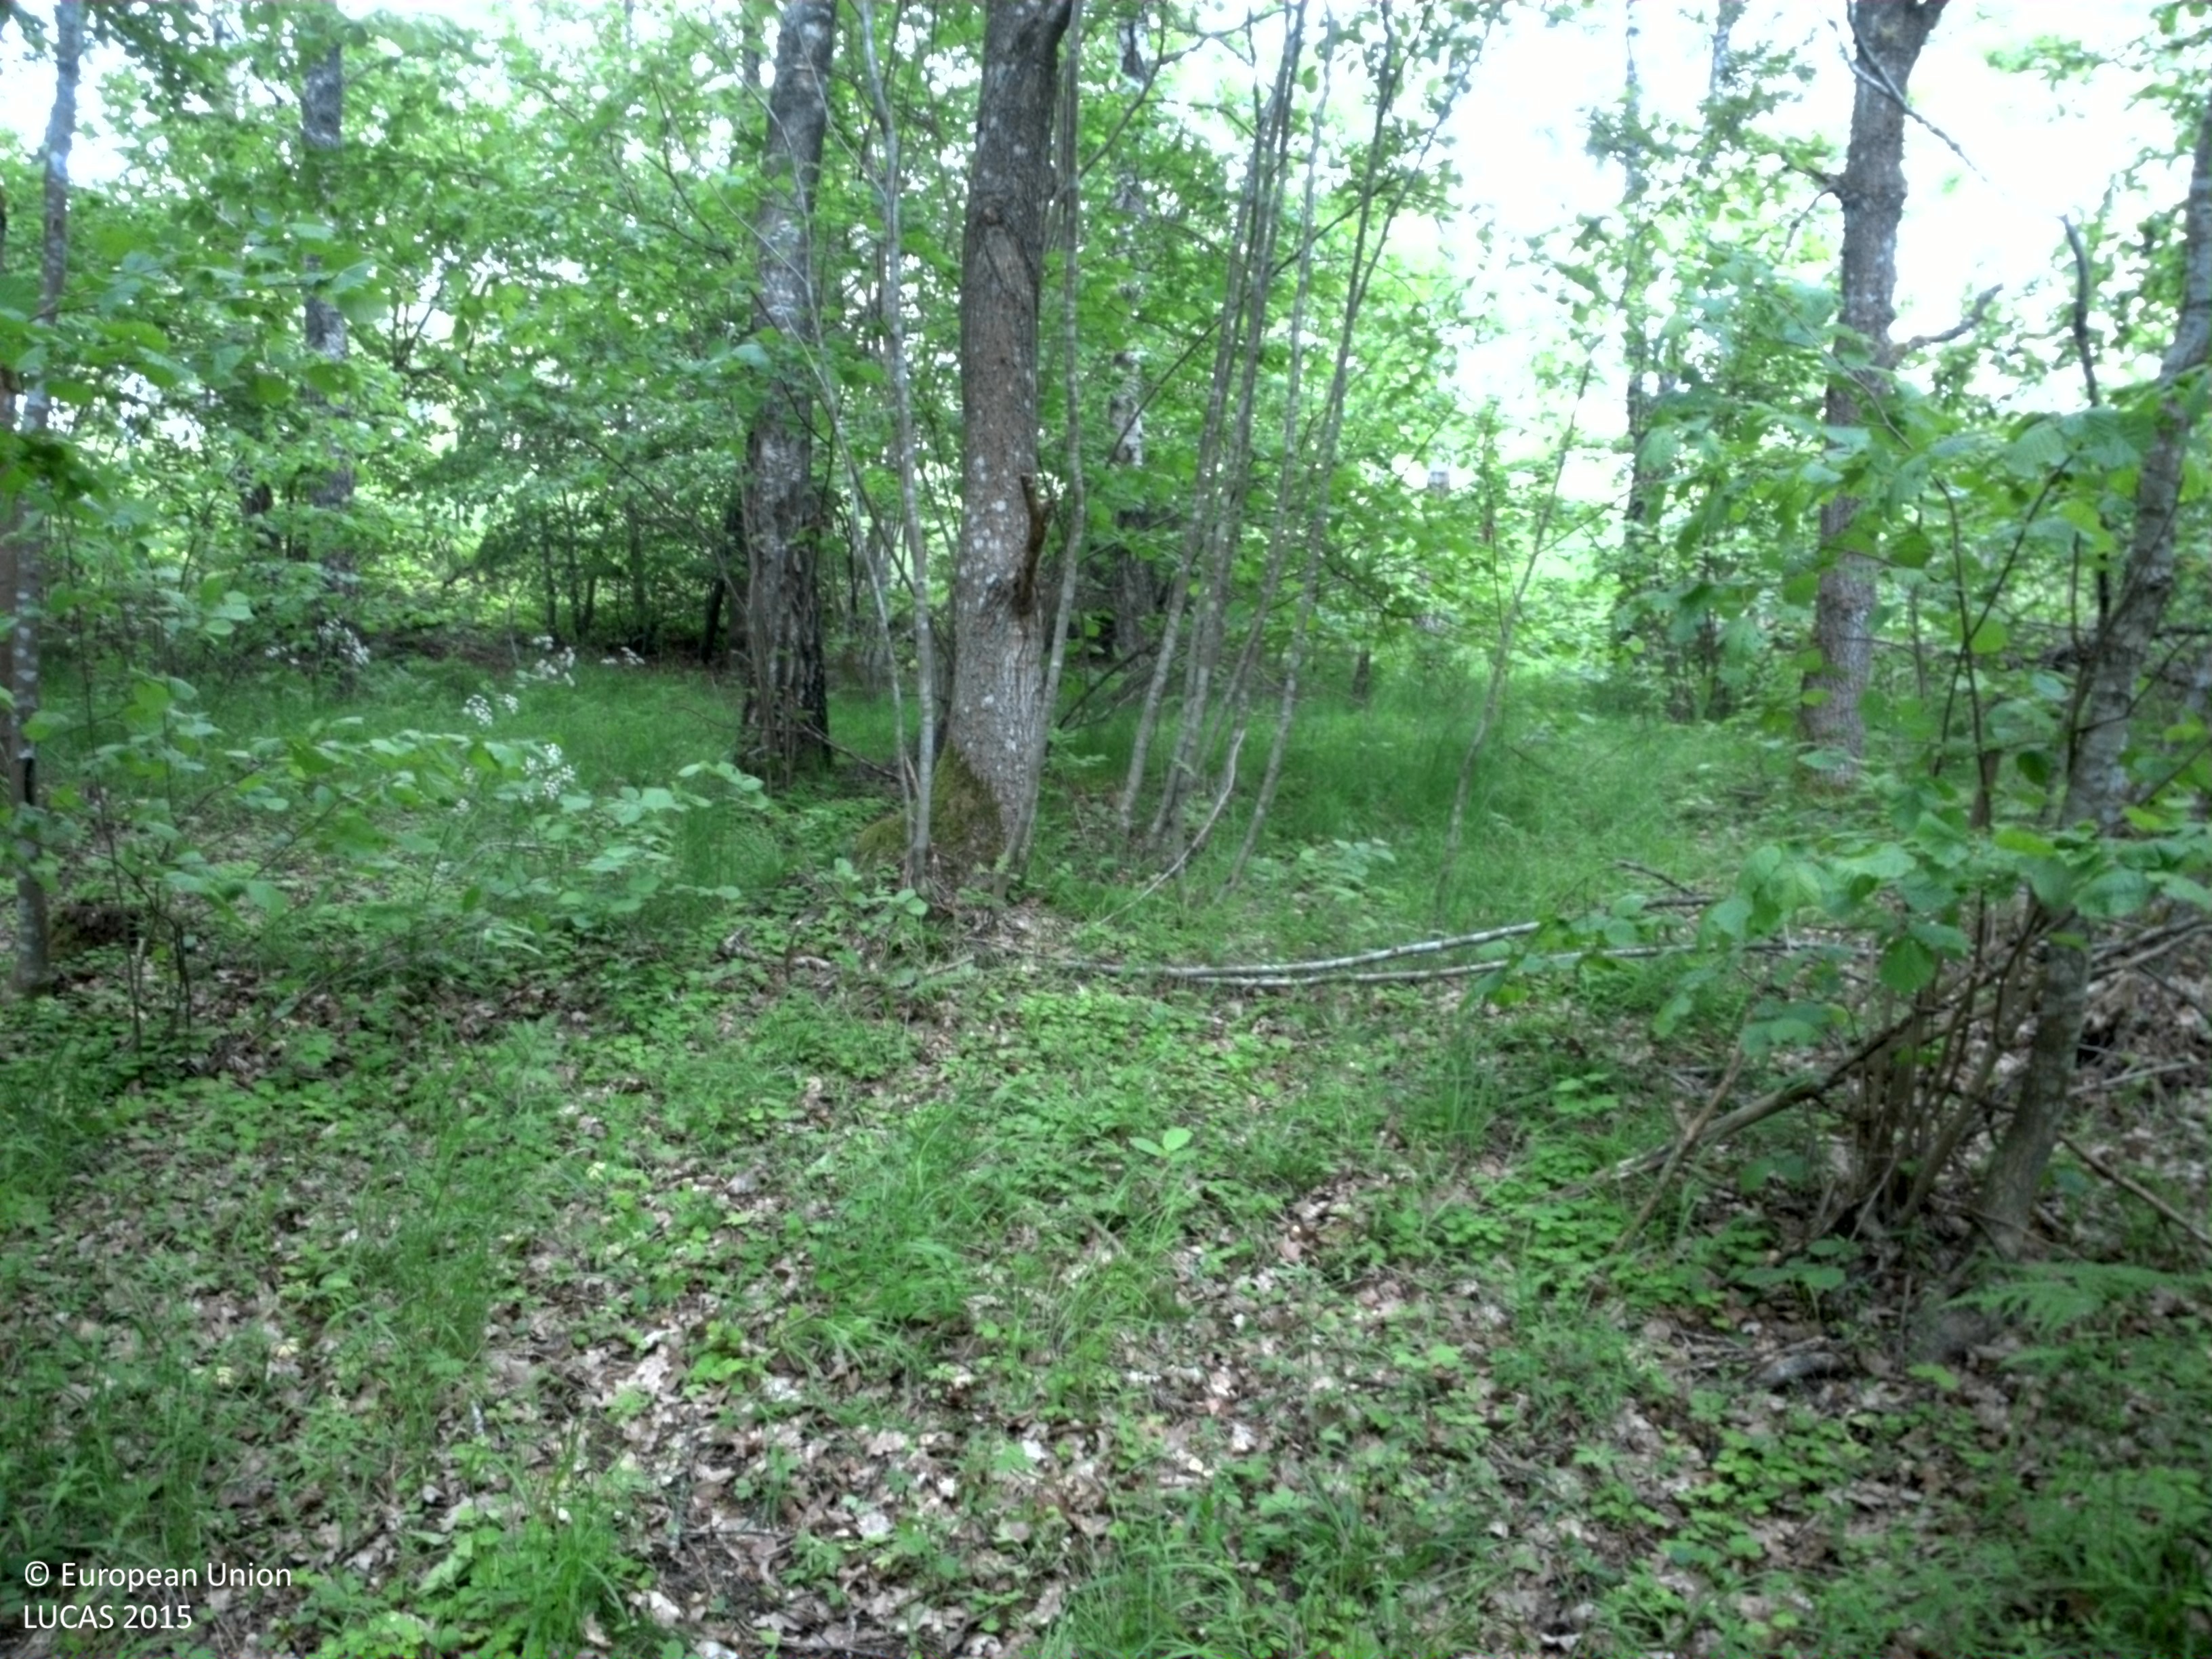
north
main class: Woodland
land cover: Broadleaved woodland
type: hemiboreal forest and nemoral coniferous forest and mixed broadleaved-coniferous forest
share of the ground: 50 - 75 %
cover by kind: broadleaved forest trees 70 %, herbaceous plants 30 %
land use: Forestry
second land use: Amenities, museums, leisure
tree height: > 5 m
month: June
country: SE
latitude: 58.6712
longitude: 16.2197
